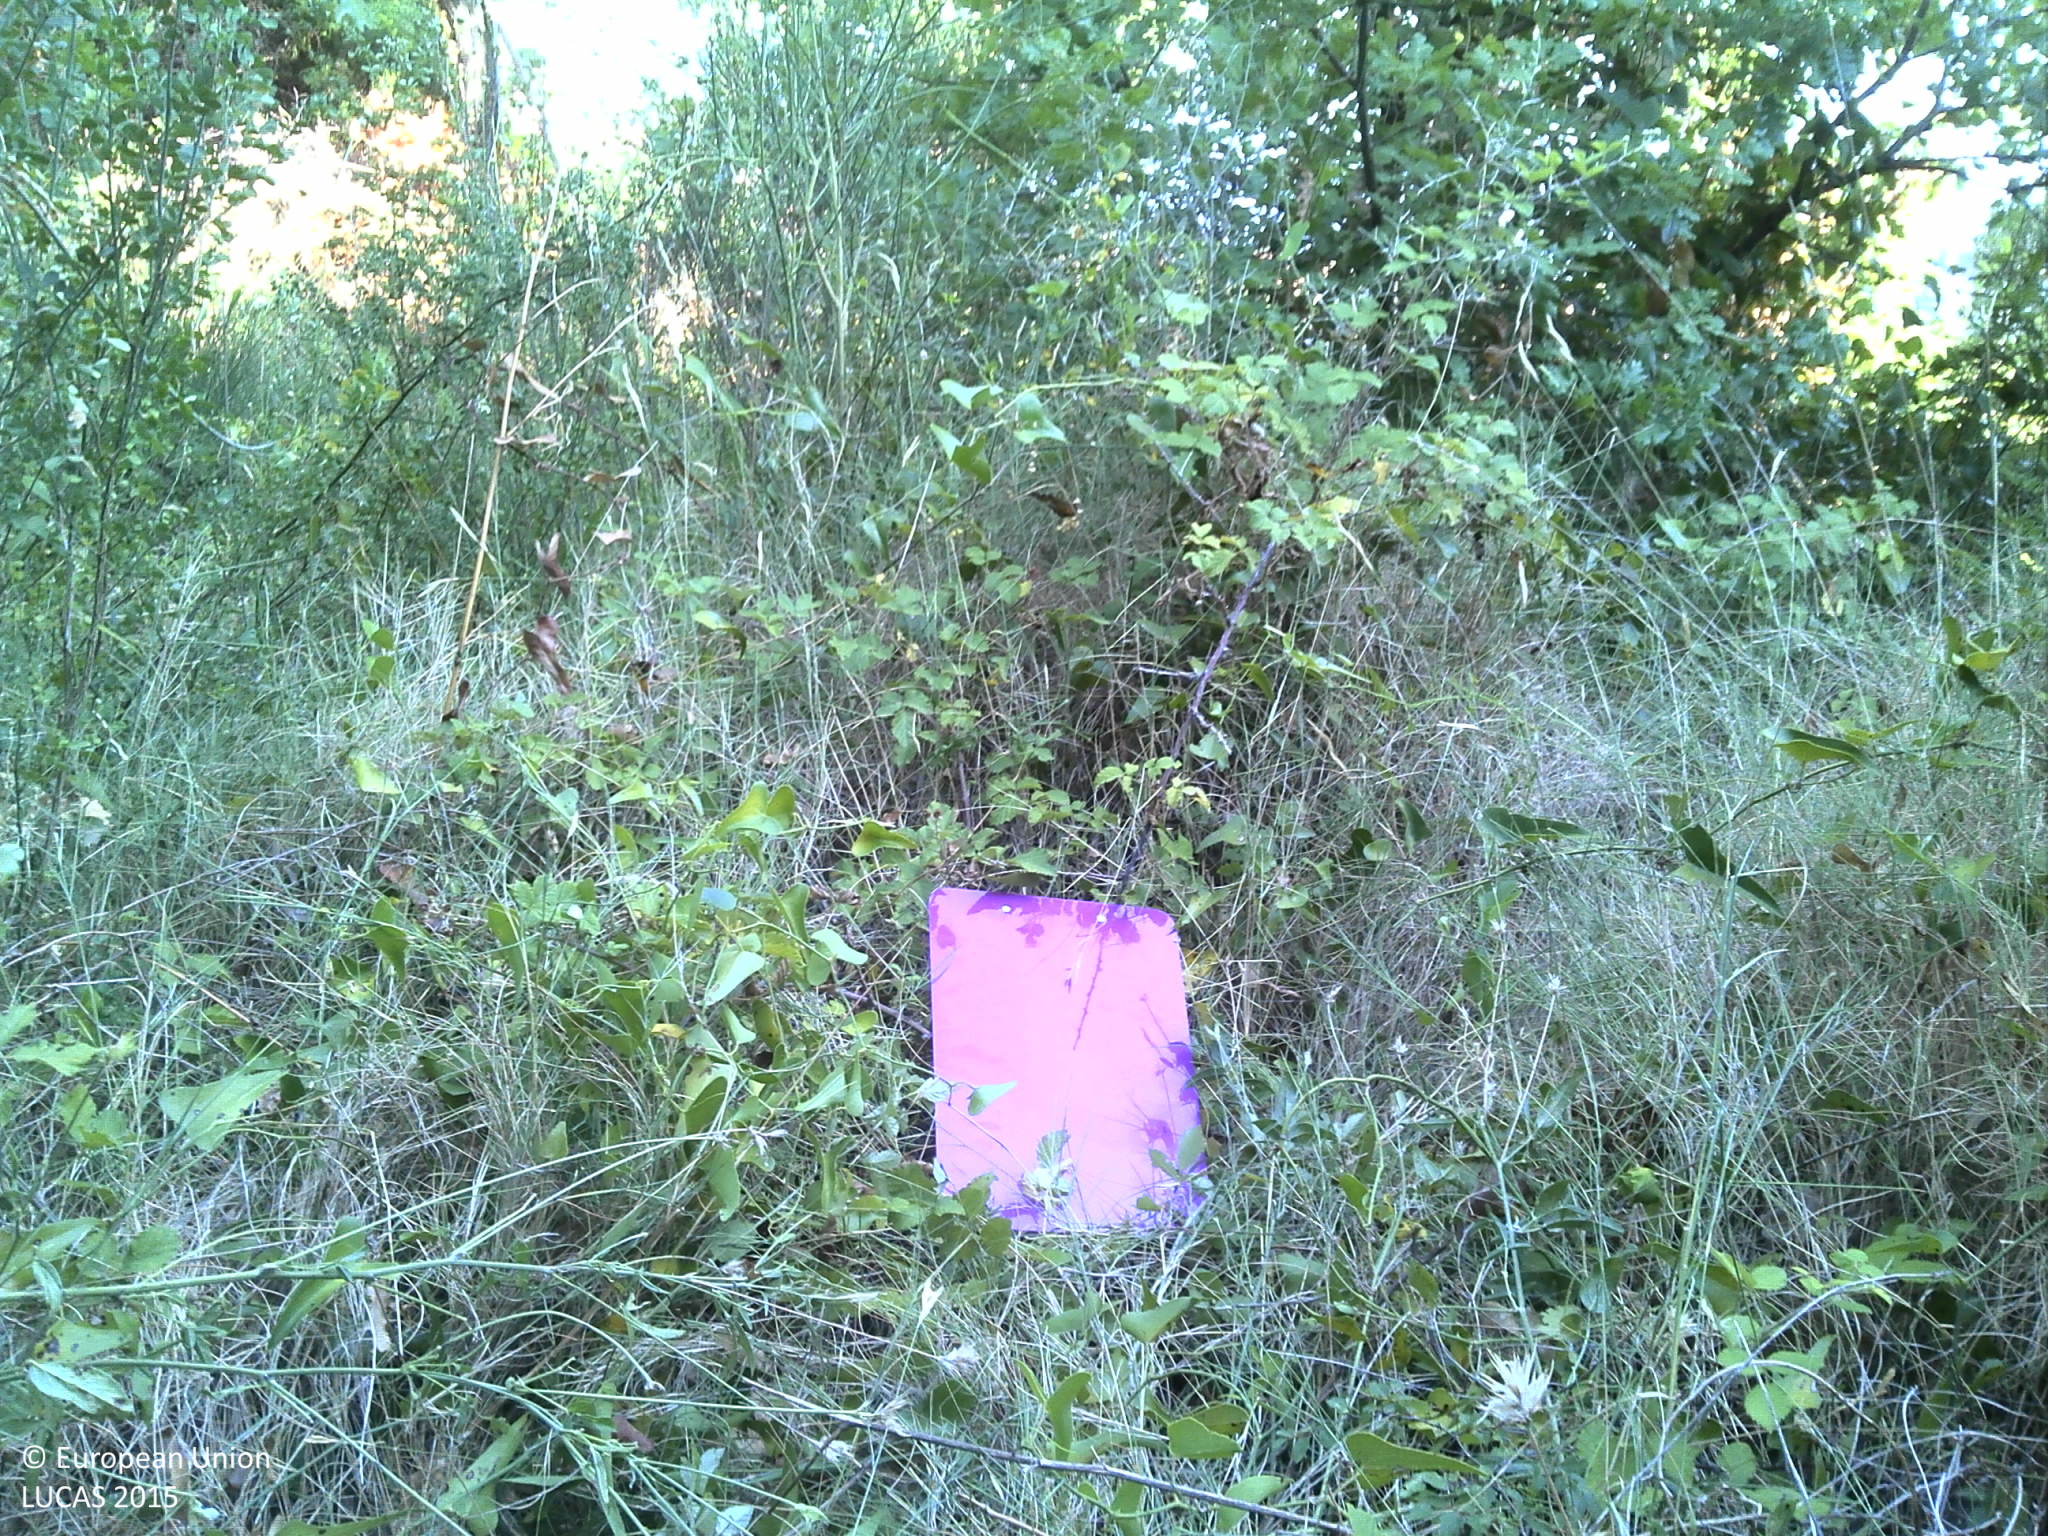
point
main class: Shrubland
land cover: Shrubland with sparse tree cover
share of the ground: 50 - 75 %
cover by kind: shrubs 60 %, herbaceous plants 15 %, unconsolidated bare surface 15 %, broadleaved forest trees 5 %, consolidated bare surface 5 %
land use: Semi-natural and natural areas not in use
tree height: < 5 m
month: July
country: HR
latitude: 42.6298
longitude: 18.1968
